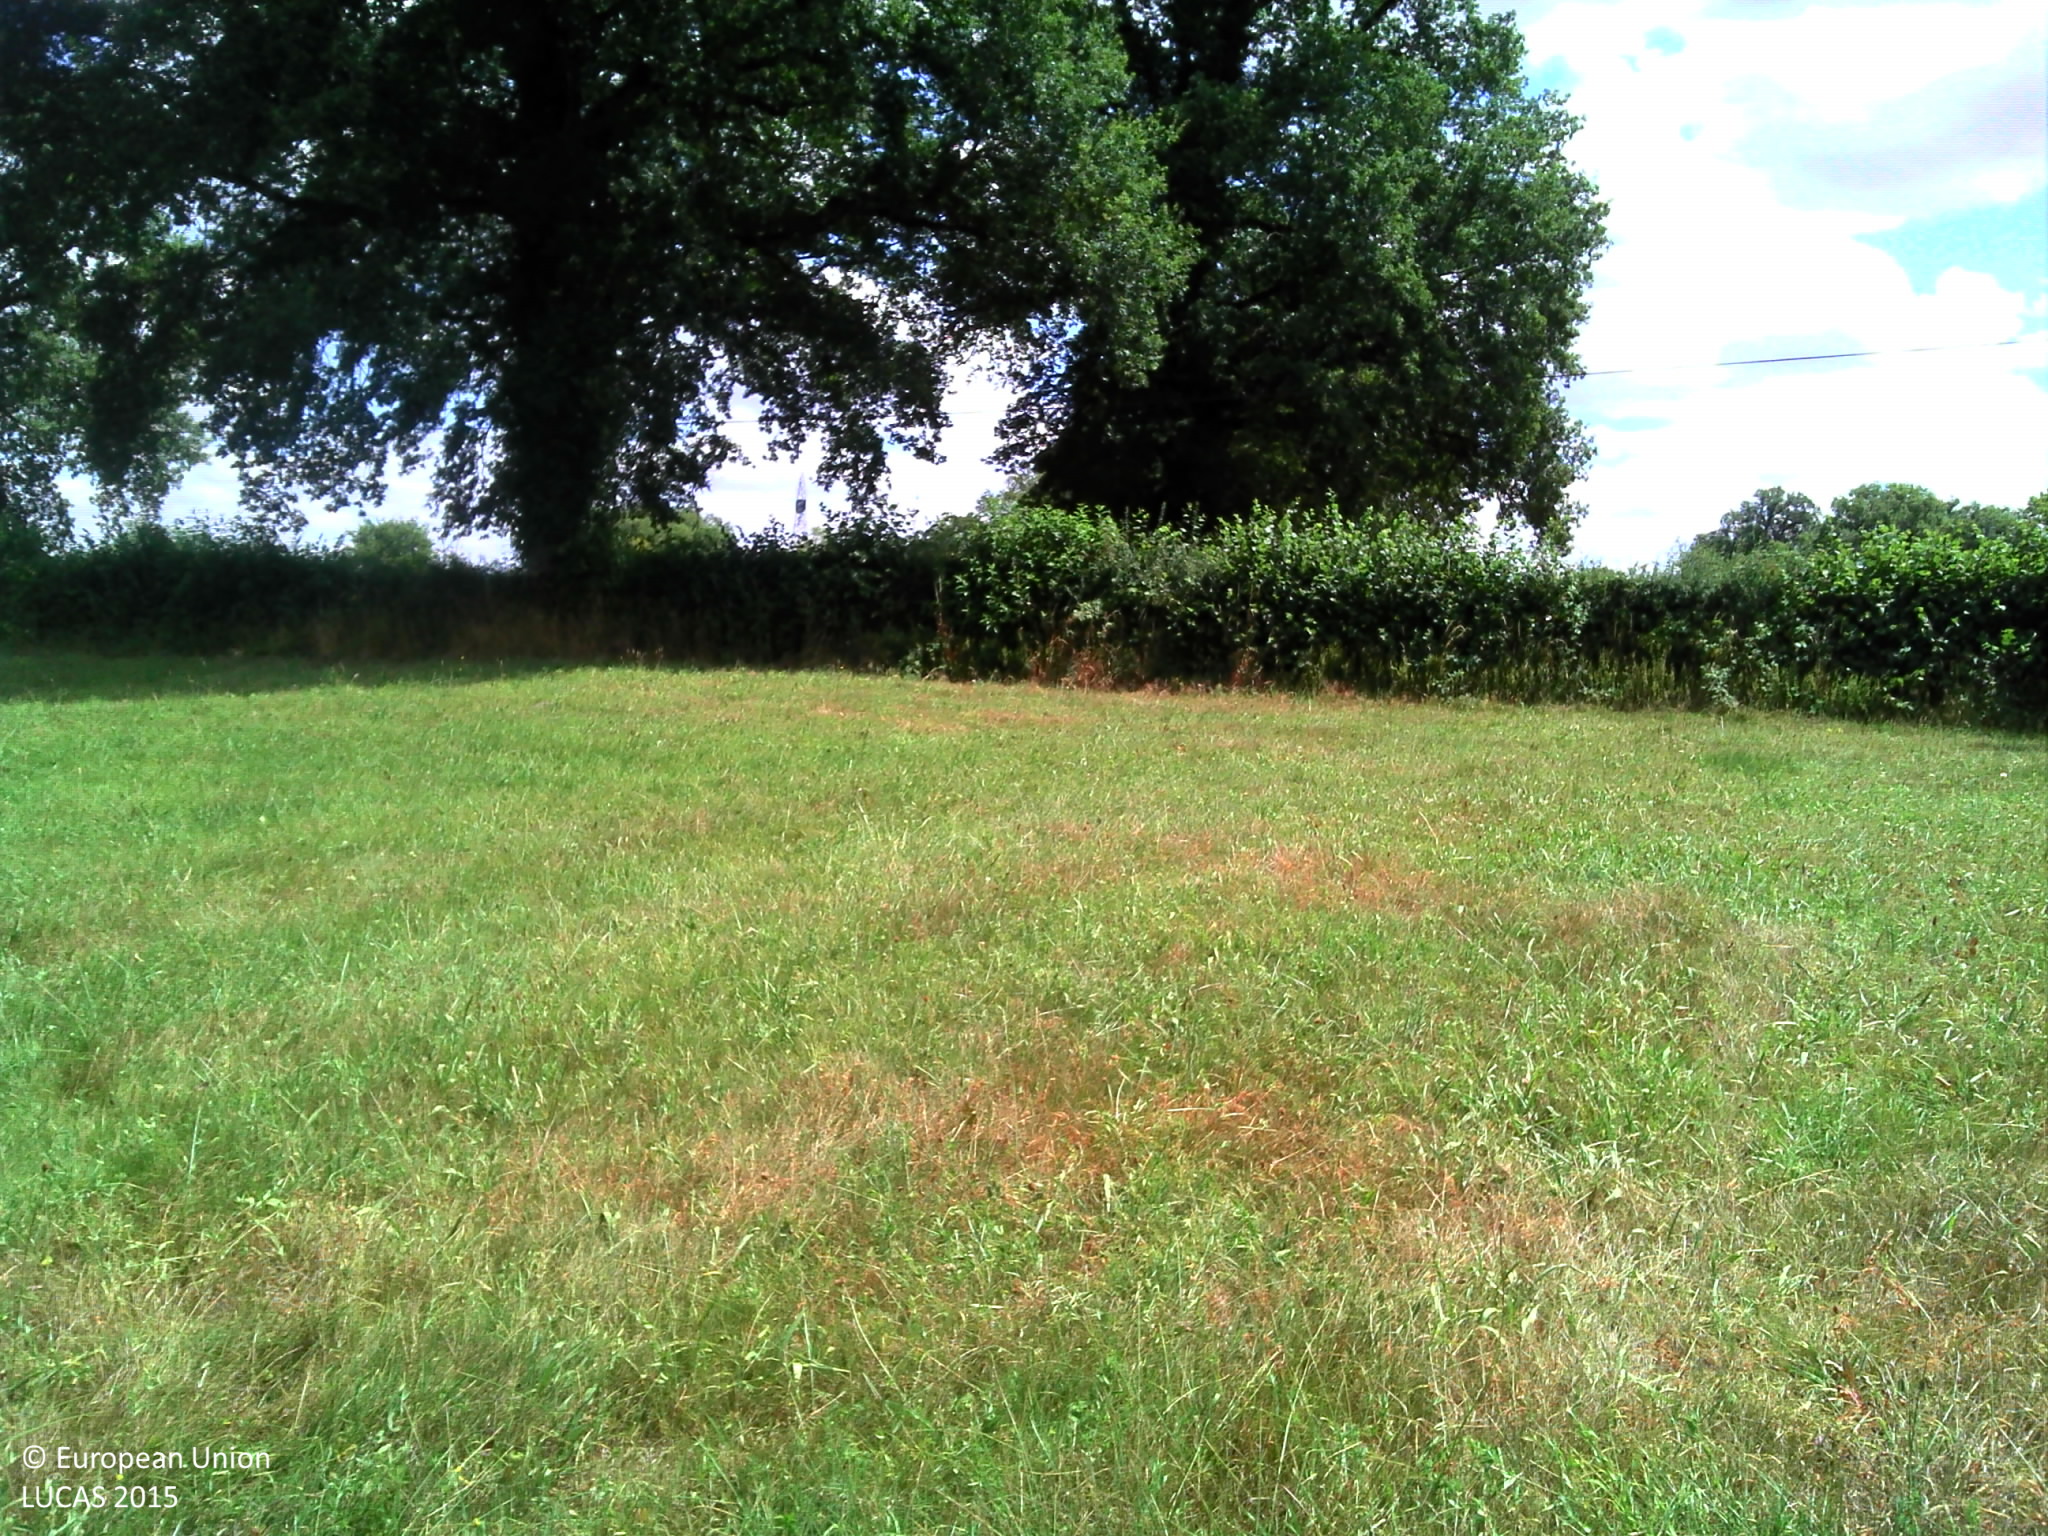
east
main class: Grassland
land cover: Grassland without tree/shrub cover
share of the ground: > 75 %
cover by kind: herbaceous plants 100 %
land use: Agriculture (excluding fallow land and kitchen gardens)
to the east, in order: Grassland without tree/shrub cover; Managed hedges; Grass margins; Paved roads, cycling and walking lanes; Electric lines; Grass margins; Ditches and canals; Managed hedges; Fences; Grassland without tree/shrub cover; Fences; Broadleaved woodland; Fences; Rivers and streams; Grassland without tree/shrub cover; Fences; Broadleaved woodland
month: July
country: FR
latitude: 46.4637
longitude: 2.1938
